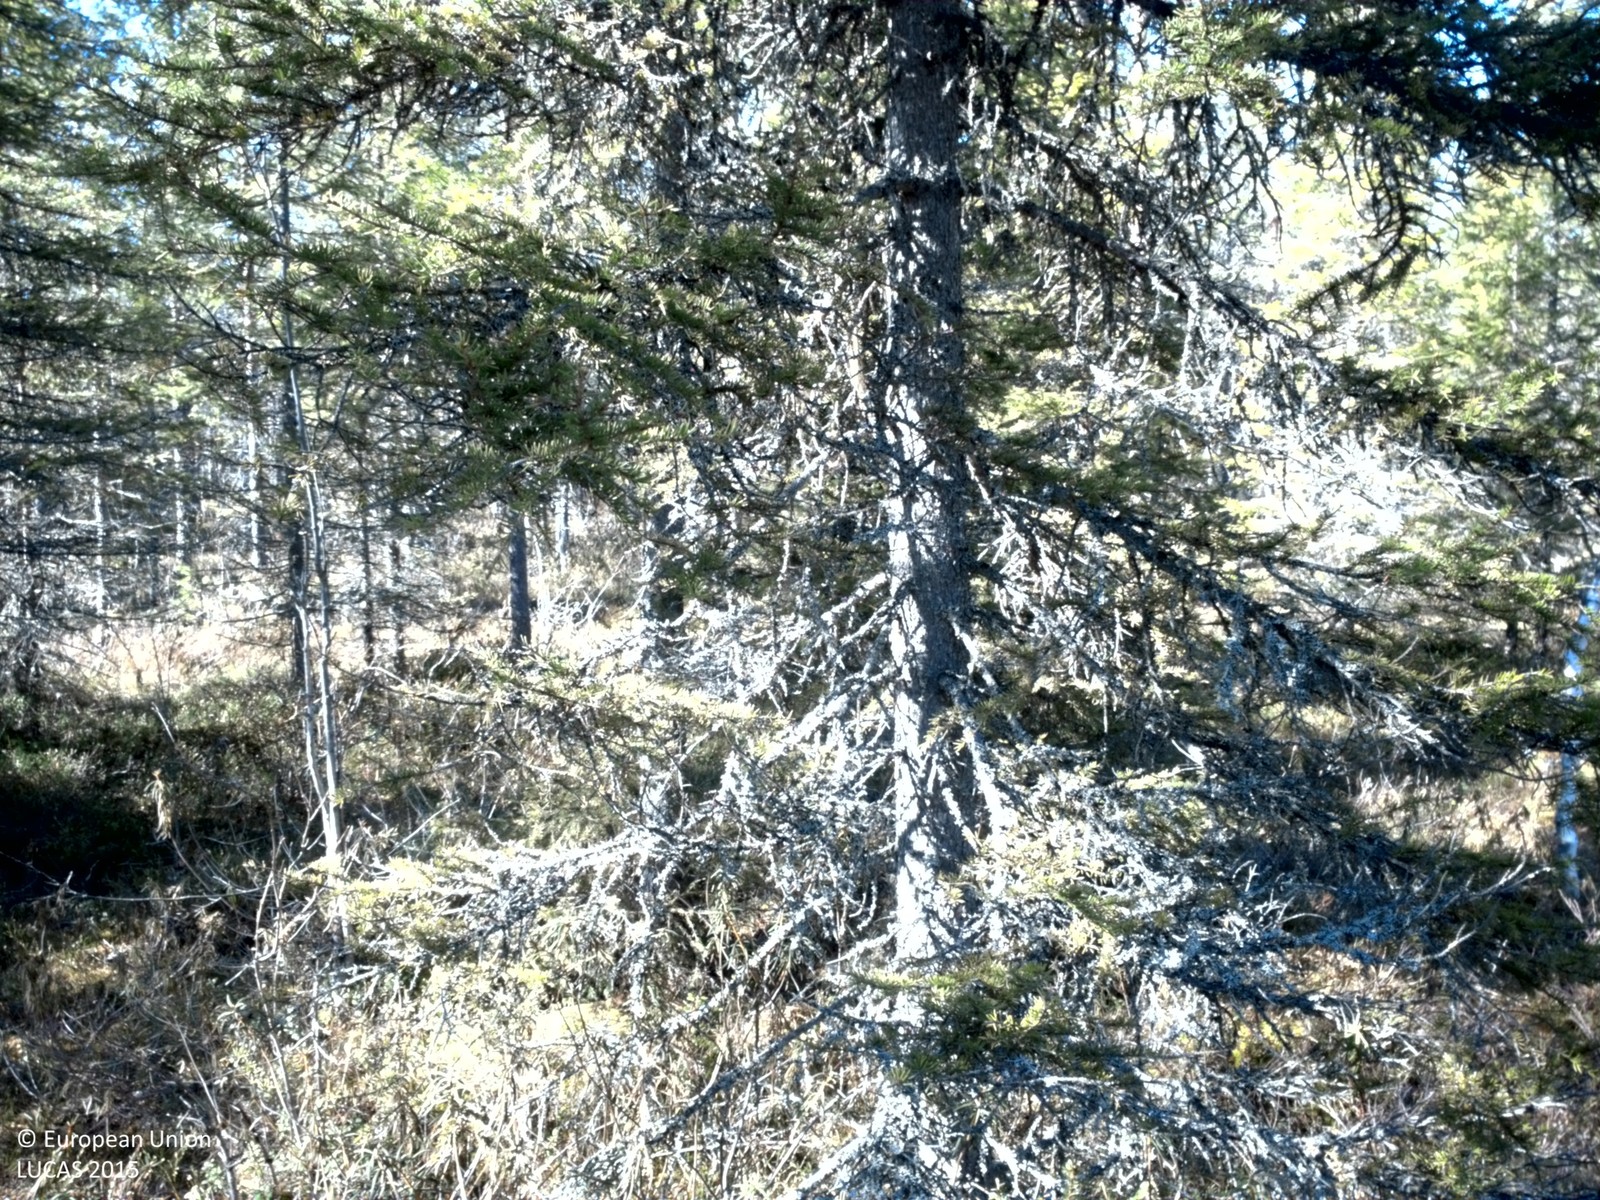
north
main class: Woodland
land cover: Other coniferous woodland
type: boreal forest
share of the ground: > 75 %
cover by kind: coniferous forest trees 75 %, shrubs 20 %, broadleaved forest trees 5 %
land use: Forestry
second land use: Community services
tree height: > 5 m
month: May
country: SE
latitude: 66.1866
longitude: 23.1005
